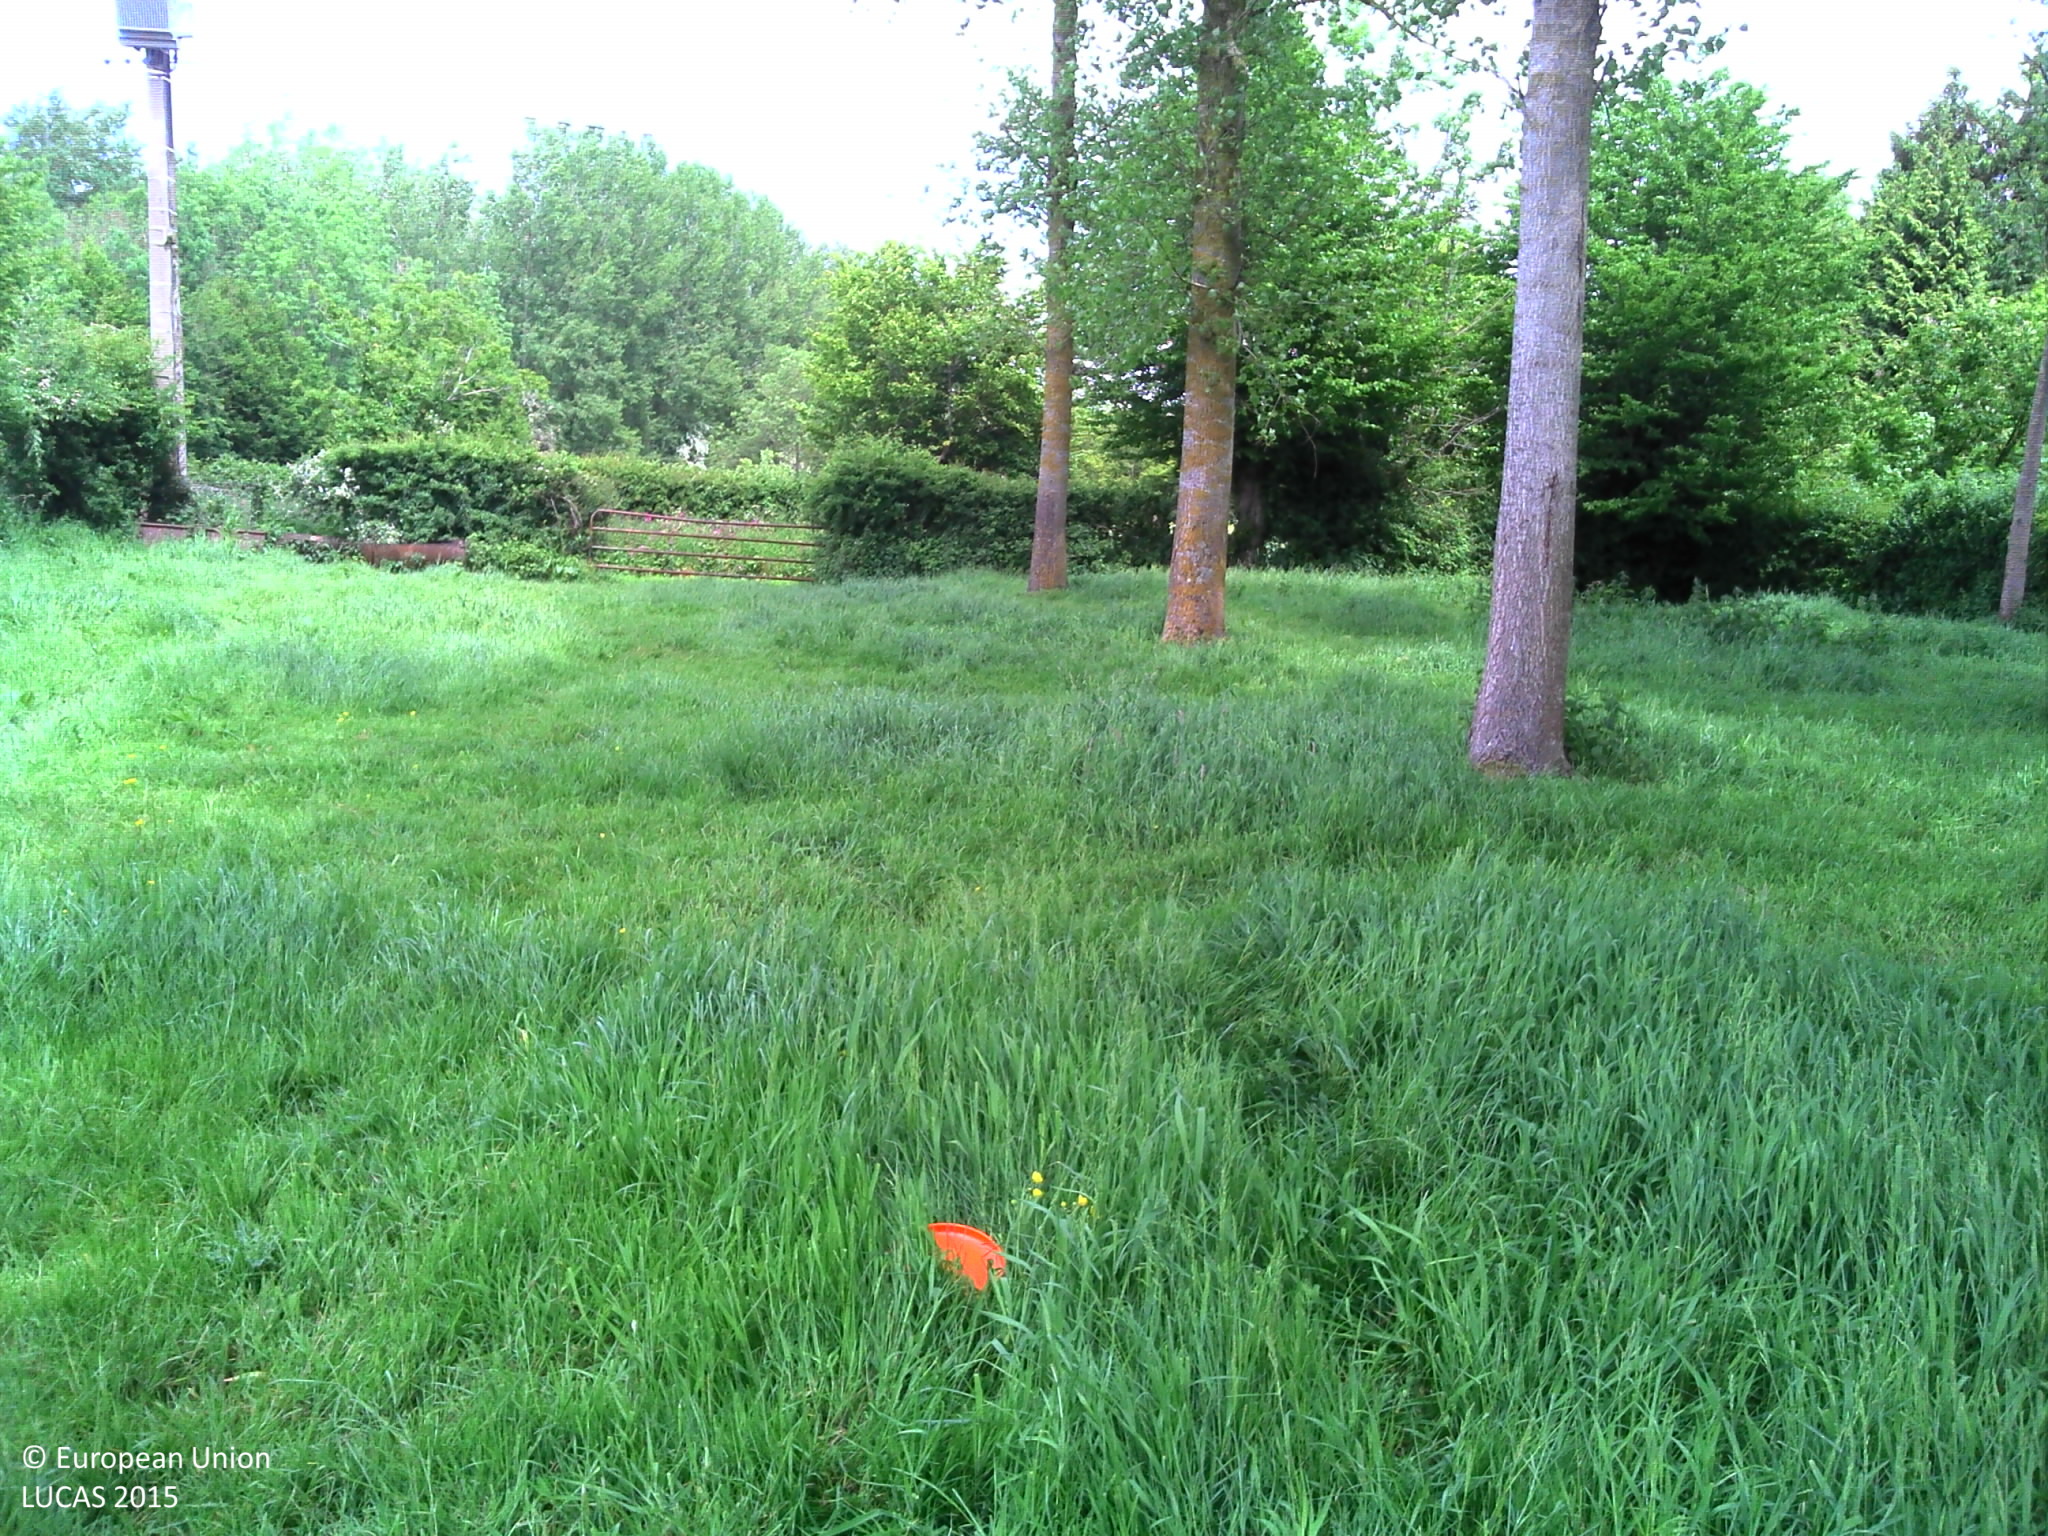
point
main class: Woodland
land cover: Broadleaved woodland
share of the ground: 50 - 75 %
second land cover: Grassland without tree/shrub cover
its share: 25 - 50 %
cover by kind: broadleaved forest trees 70 %, herbaceous plants 30 %
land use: Forestry
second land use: Agriculture (excluding fallow land and kitchen gardens)
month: May
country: FR
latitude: 50.5816
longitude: 2.1471
